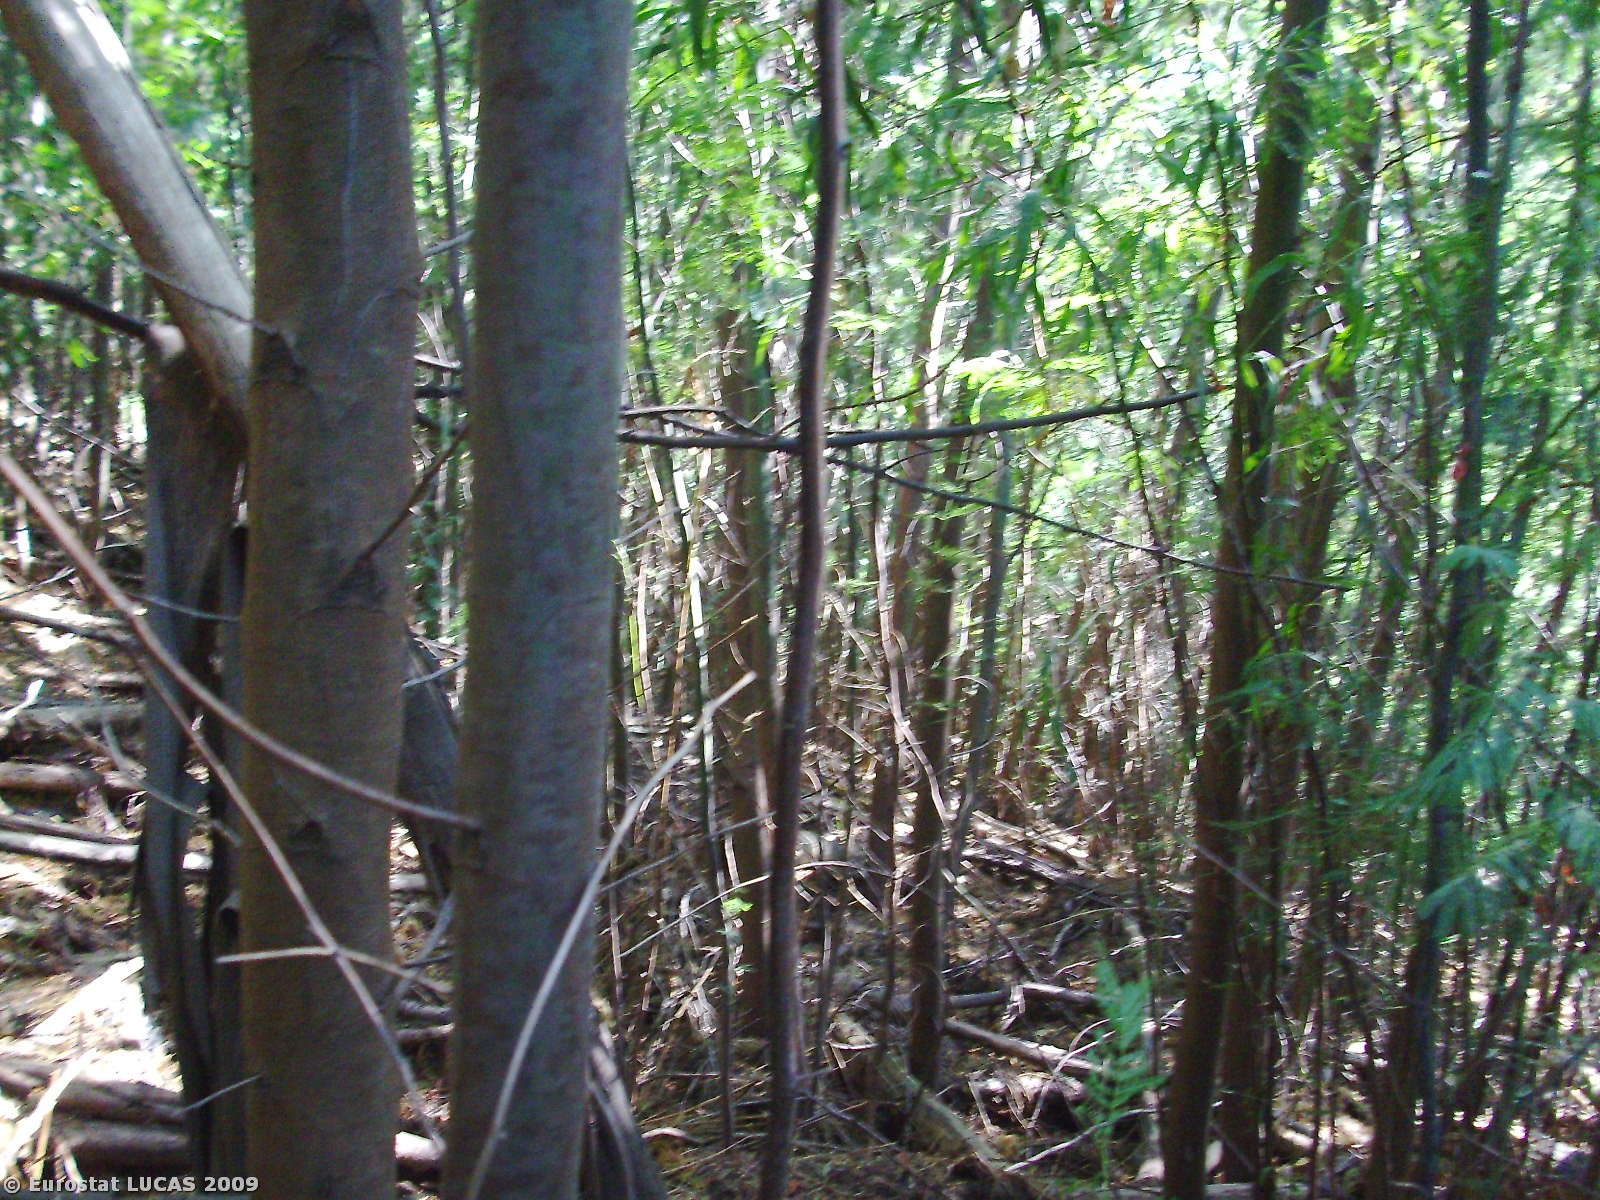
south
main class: Woodland
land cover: Broadleaved woodland
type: mesophytic deciduous forest
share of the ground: > 75 %
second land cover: Shrubland with sparse tree cover
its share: 10 - 25 %
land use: Forestry
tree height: > 5 m
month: August
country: PT
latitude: 40.1193
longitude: -8.2044
